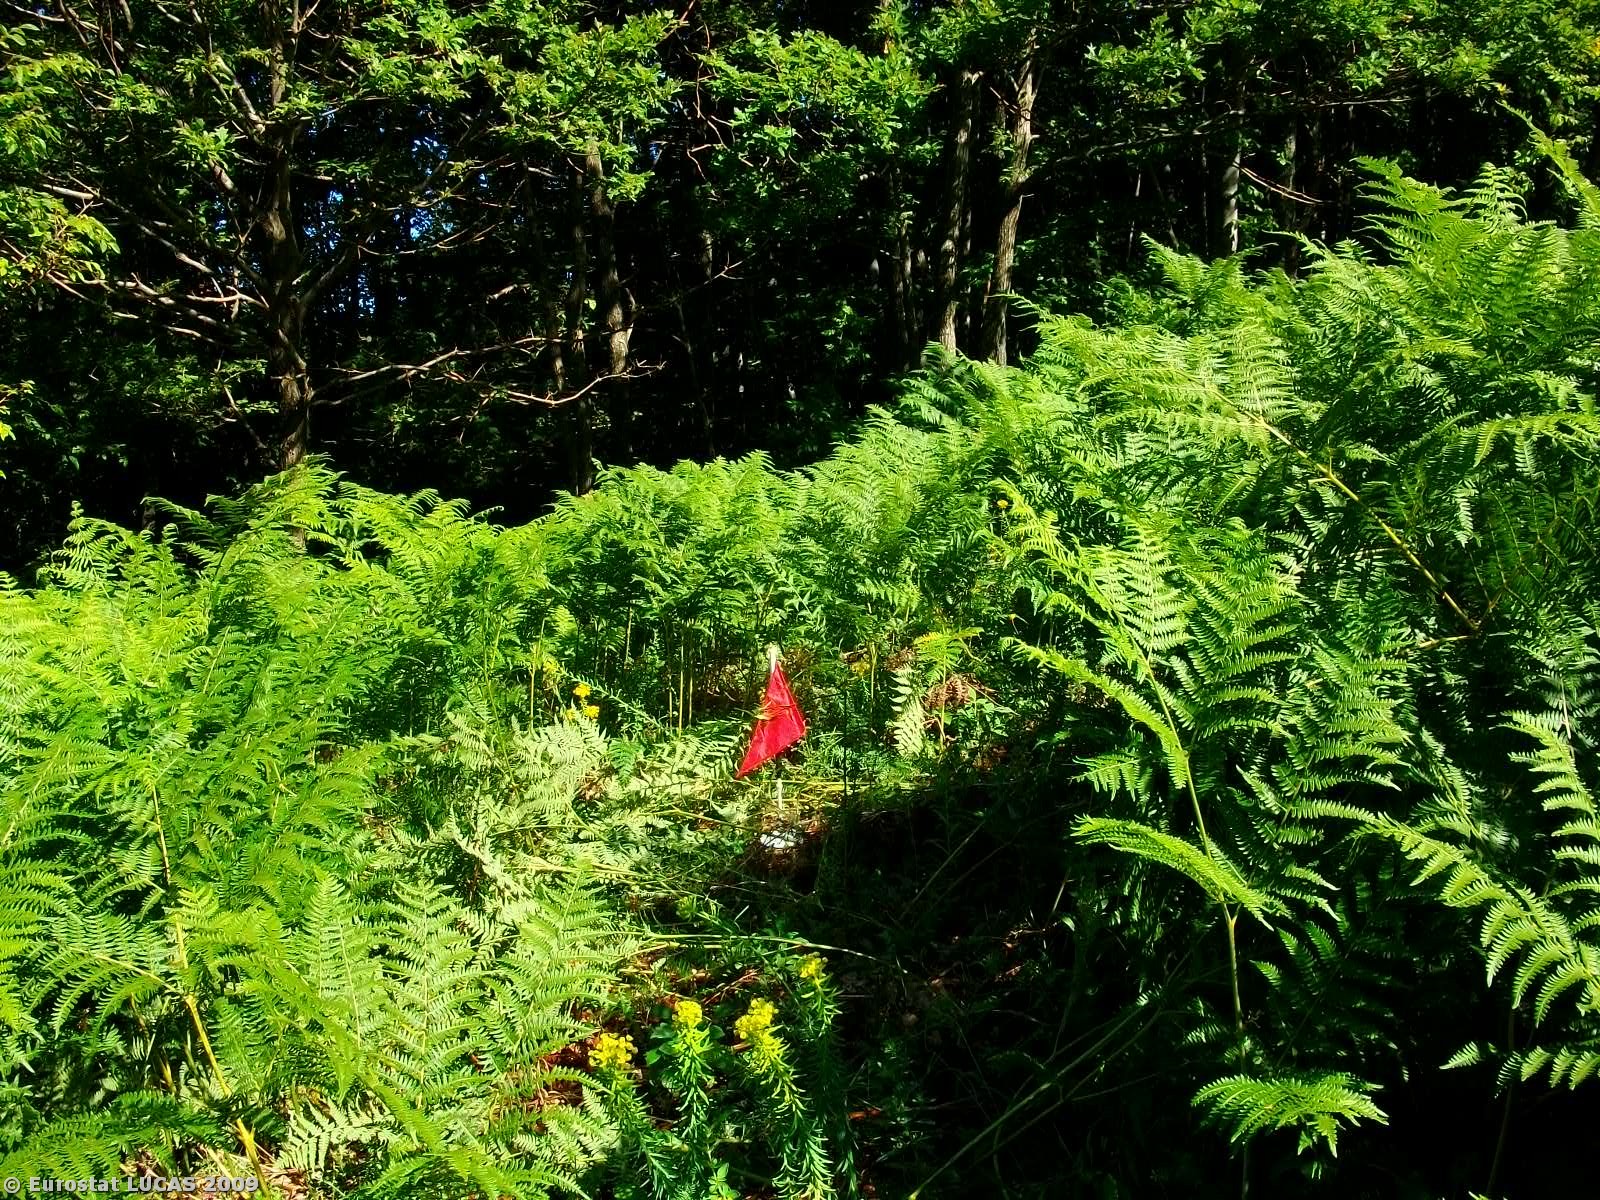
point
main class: Shrubland
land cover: Shrubland with sparse tree cover
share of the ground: > 75 %
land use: Agriculture (excluding fallow land and kitchen gardens)
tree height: > 5 m
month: June
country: GR
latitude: 41.2734
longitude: 25.5875
